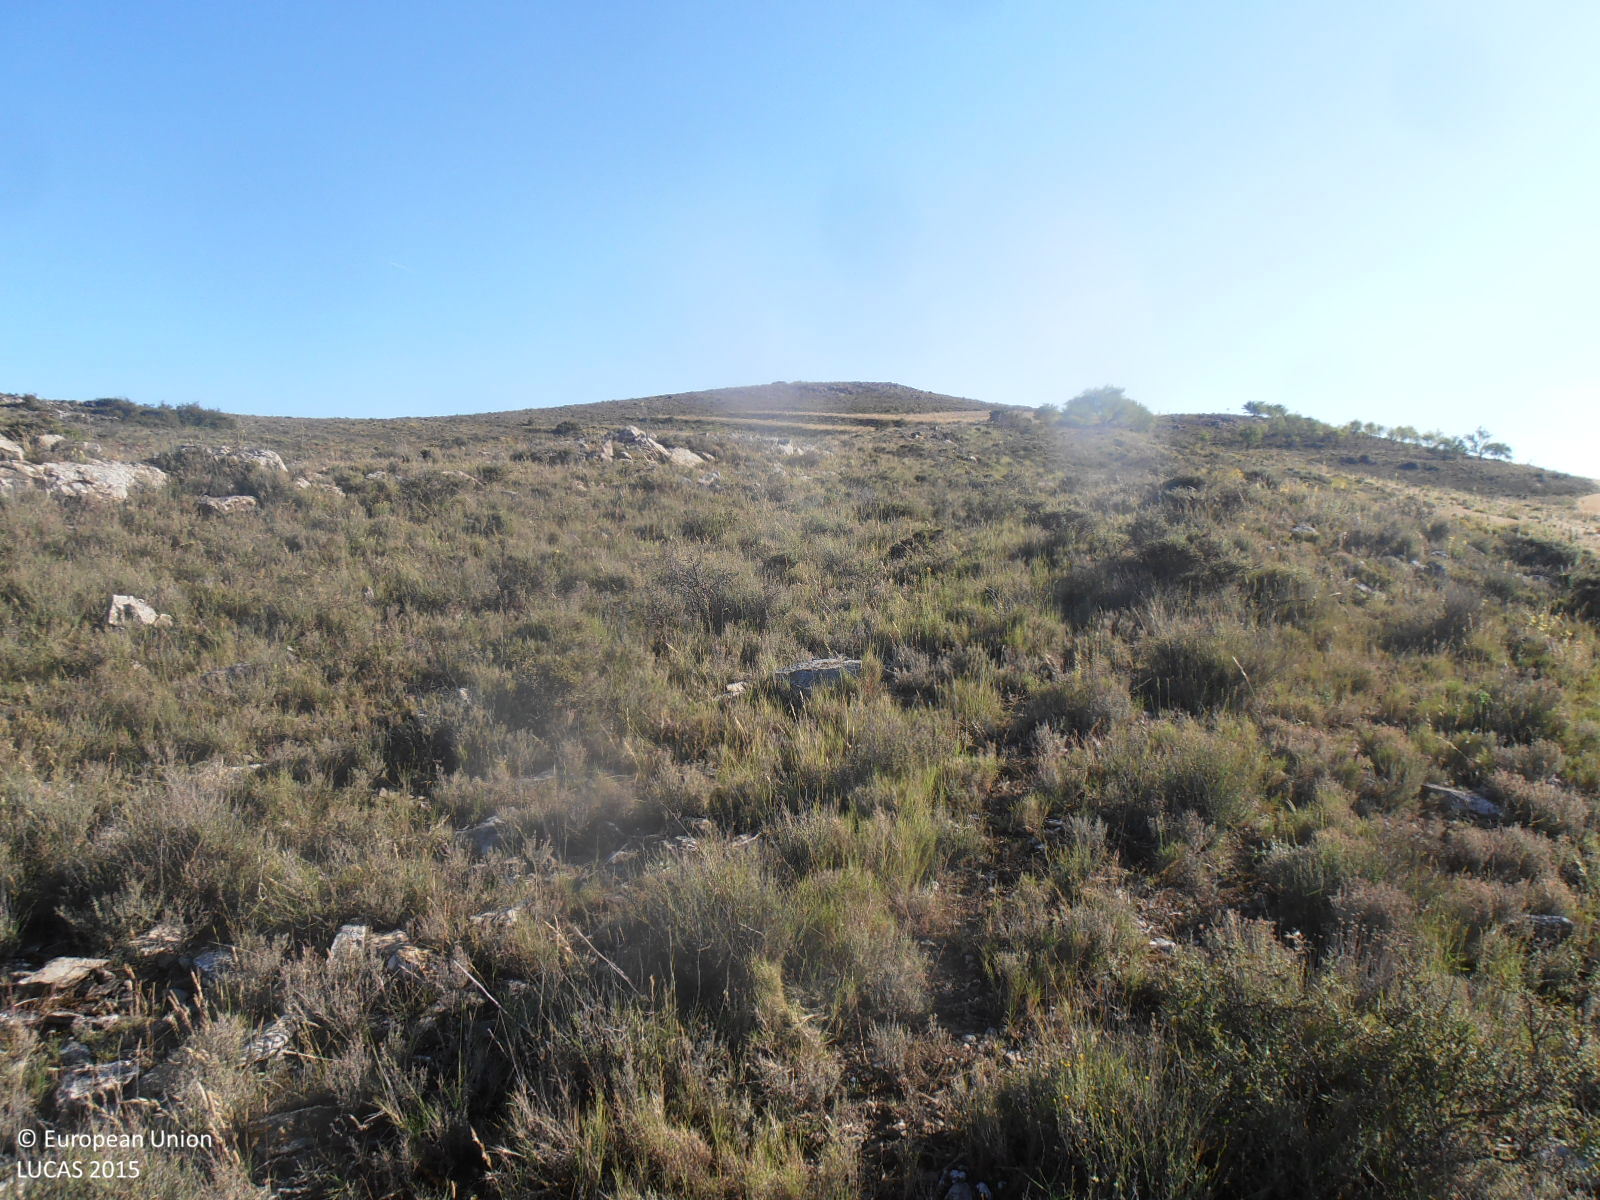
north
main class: Shrubland
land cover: Shrubland without tree cover
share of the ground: > 75 %
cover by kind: shrubs 80 %, herbaceous plants 10 %, consolidated bare surface 10 %
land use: Semi-natural and natural areas not in use
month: June
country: ES
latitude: 41.8325
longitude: -1.9661
